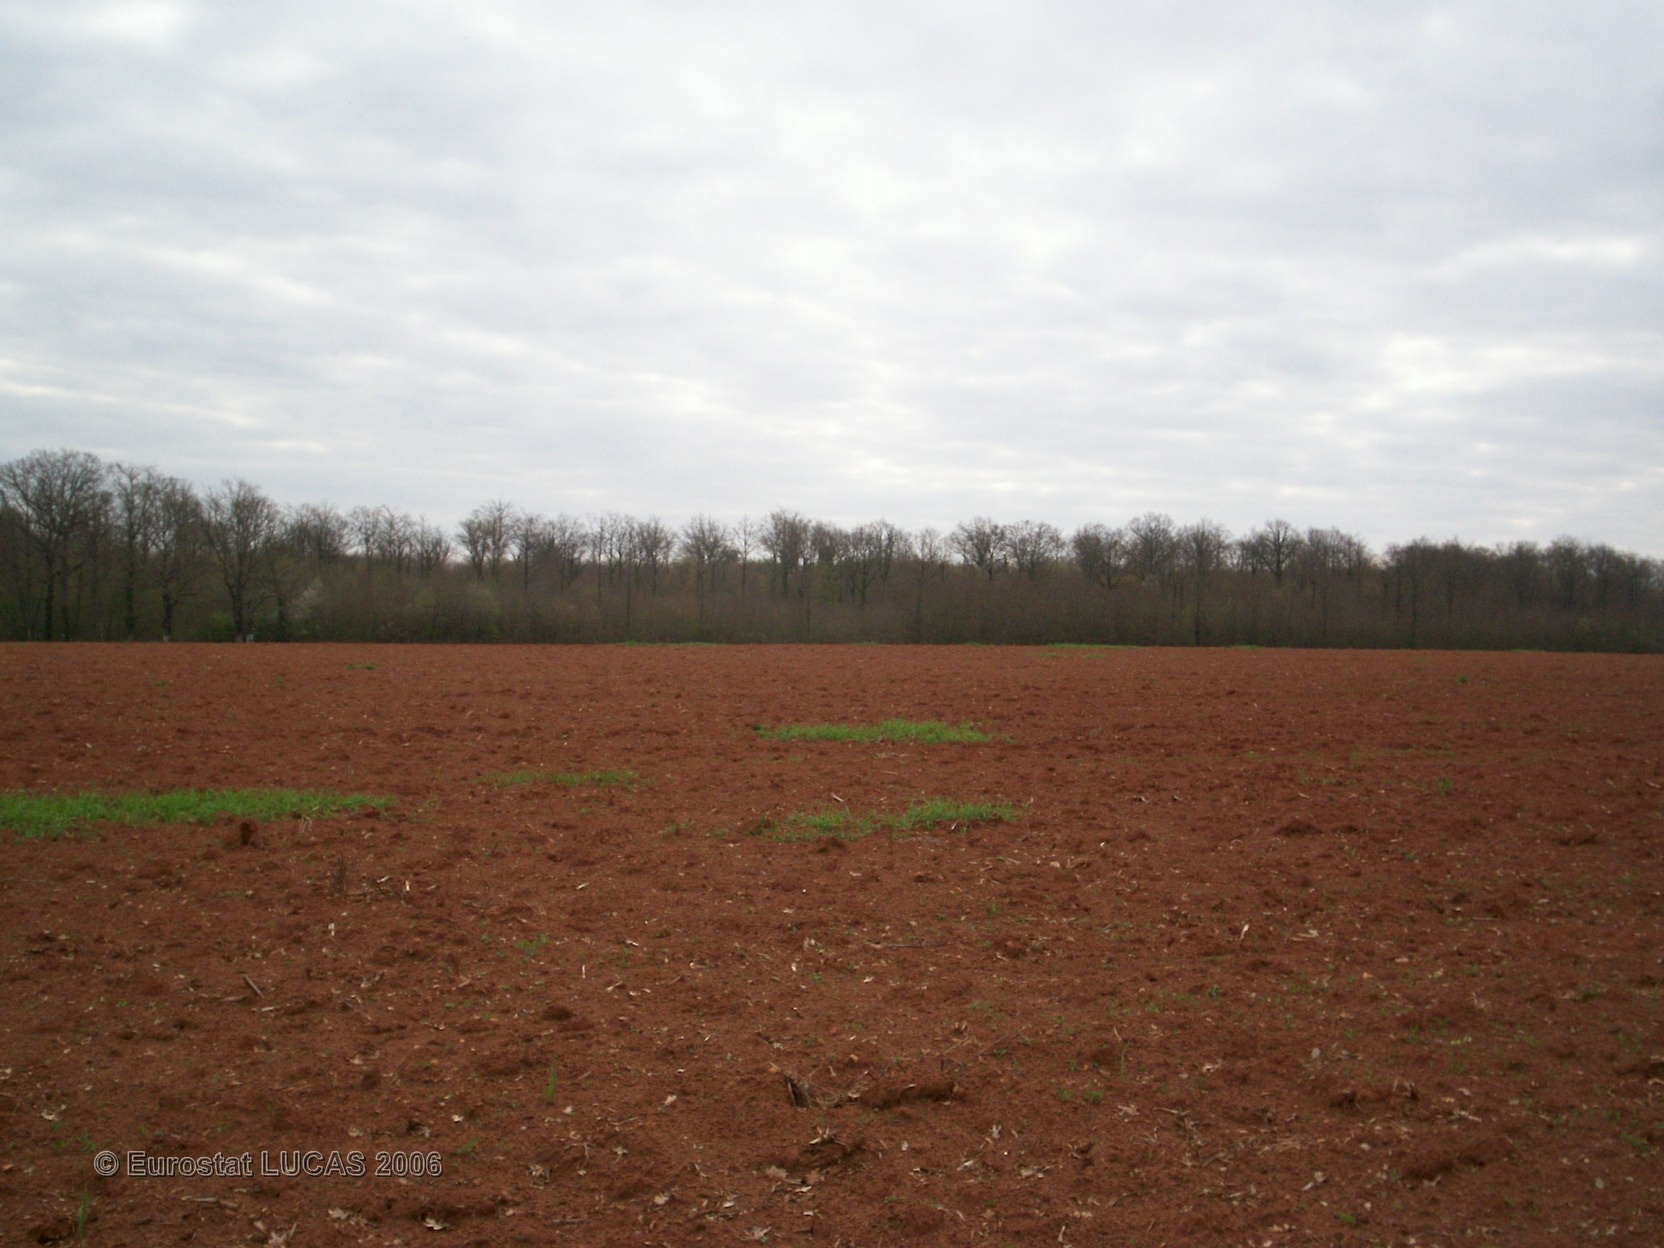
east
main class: Cropland
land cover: Maize
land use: Agriculture (excluding fallow land and kitchen gardens)
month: May
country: FR
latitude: 46.1313
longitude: 0.5490
